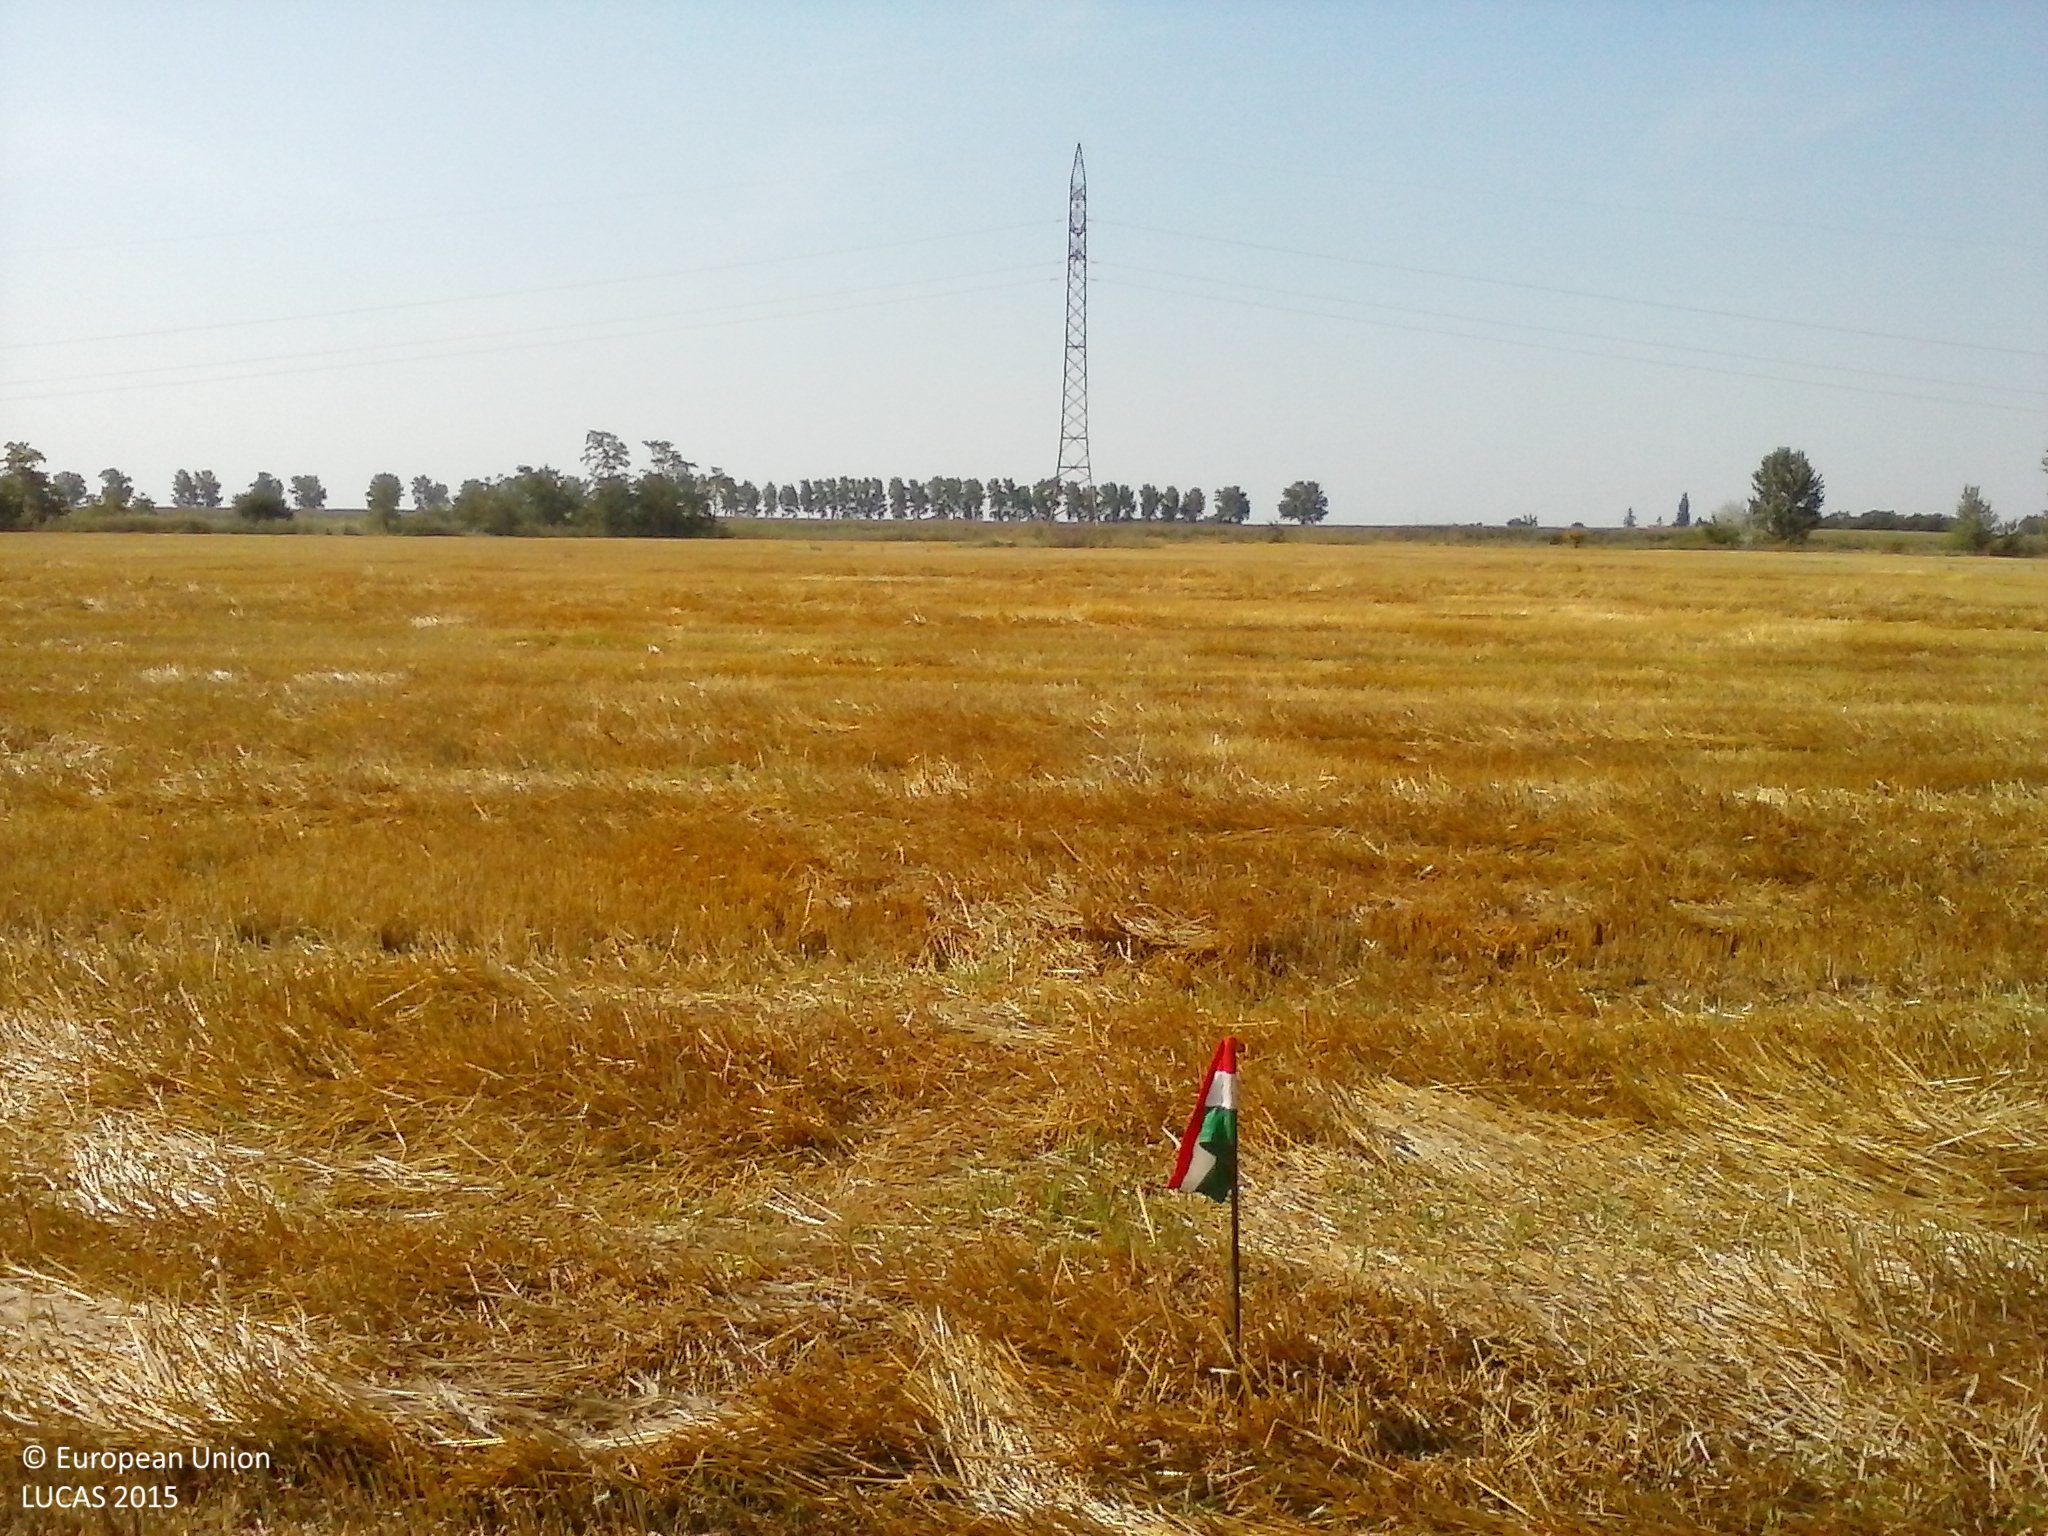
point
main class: Cropland
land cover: Common wheat
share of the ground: > 75 %
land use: Agriculture (excluding fallow land and kitchen gardens)
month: June
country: HU
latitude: 46.6607
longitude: 20.3897
